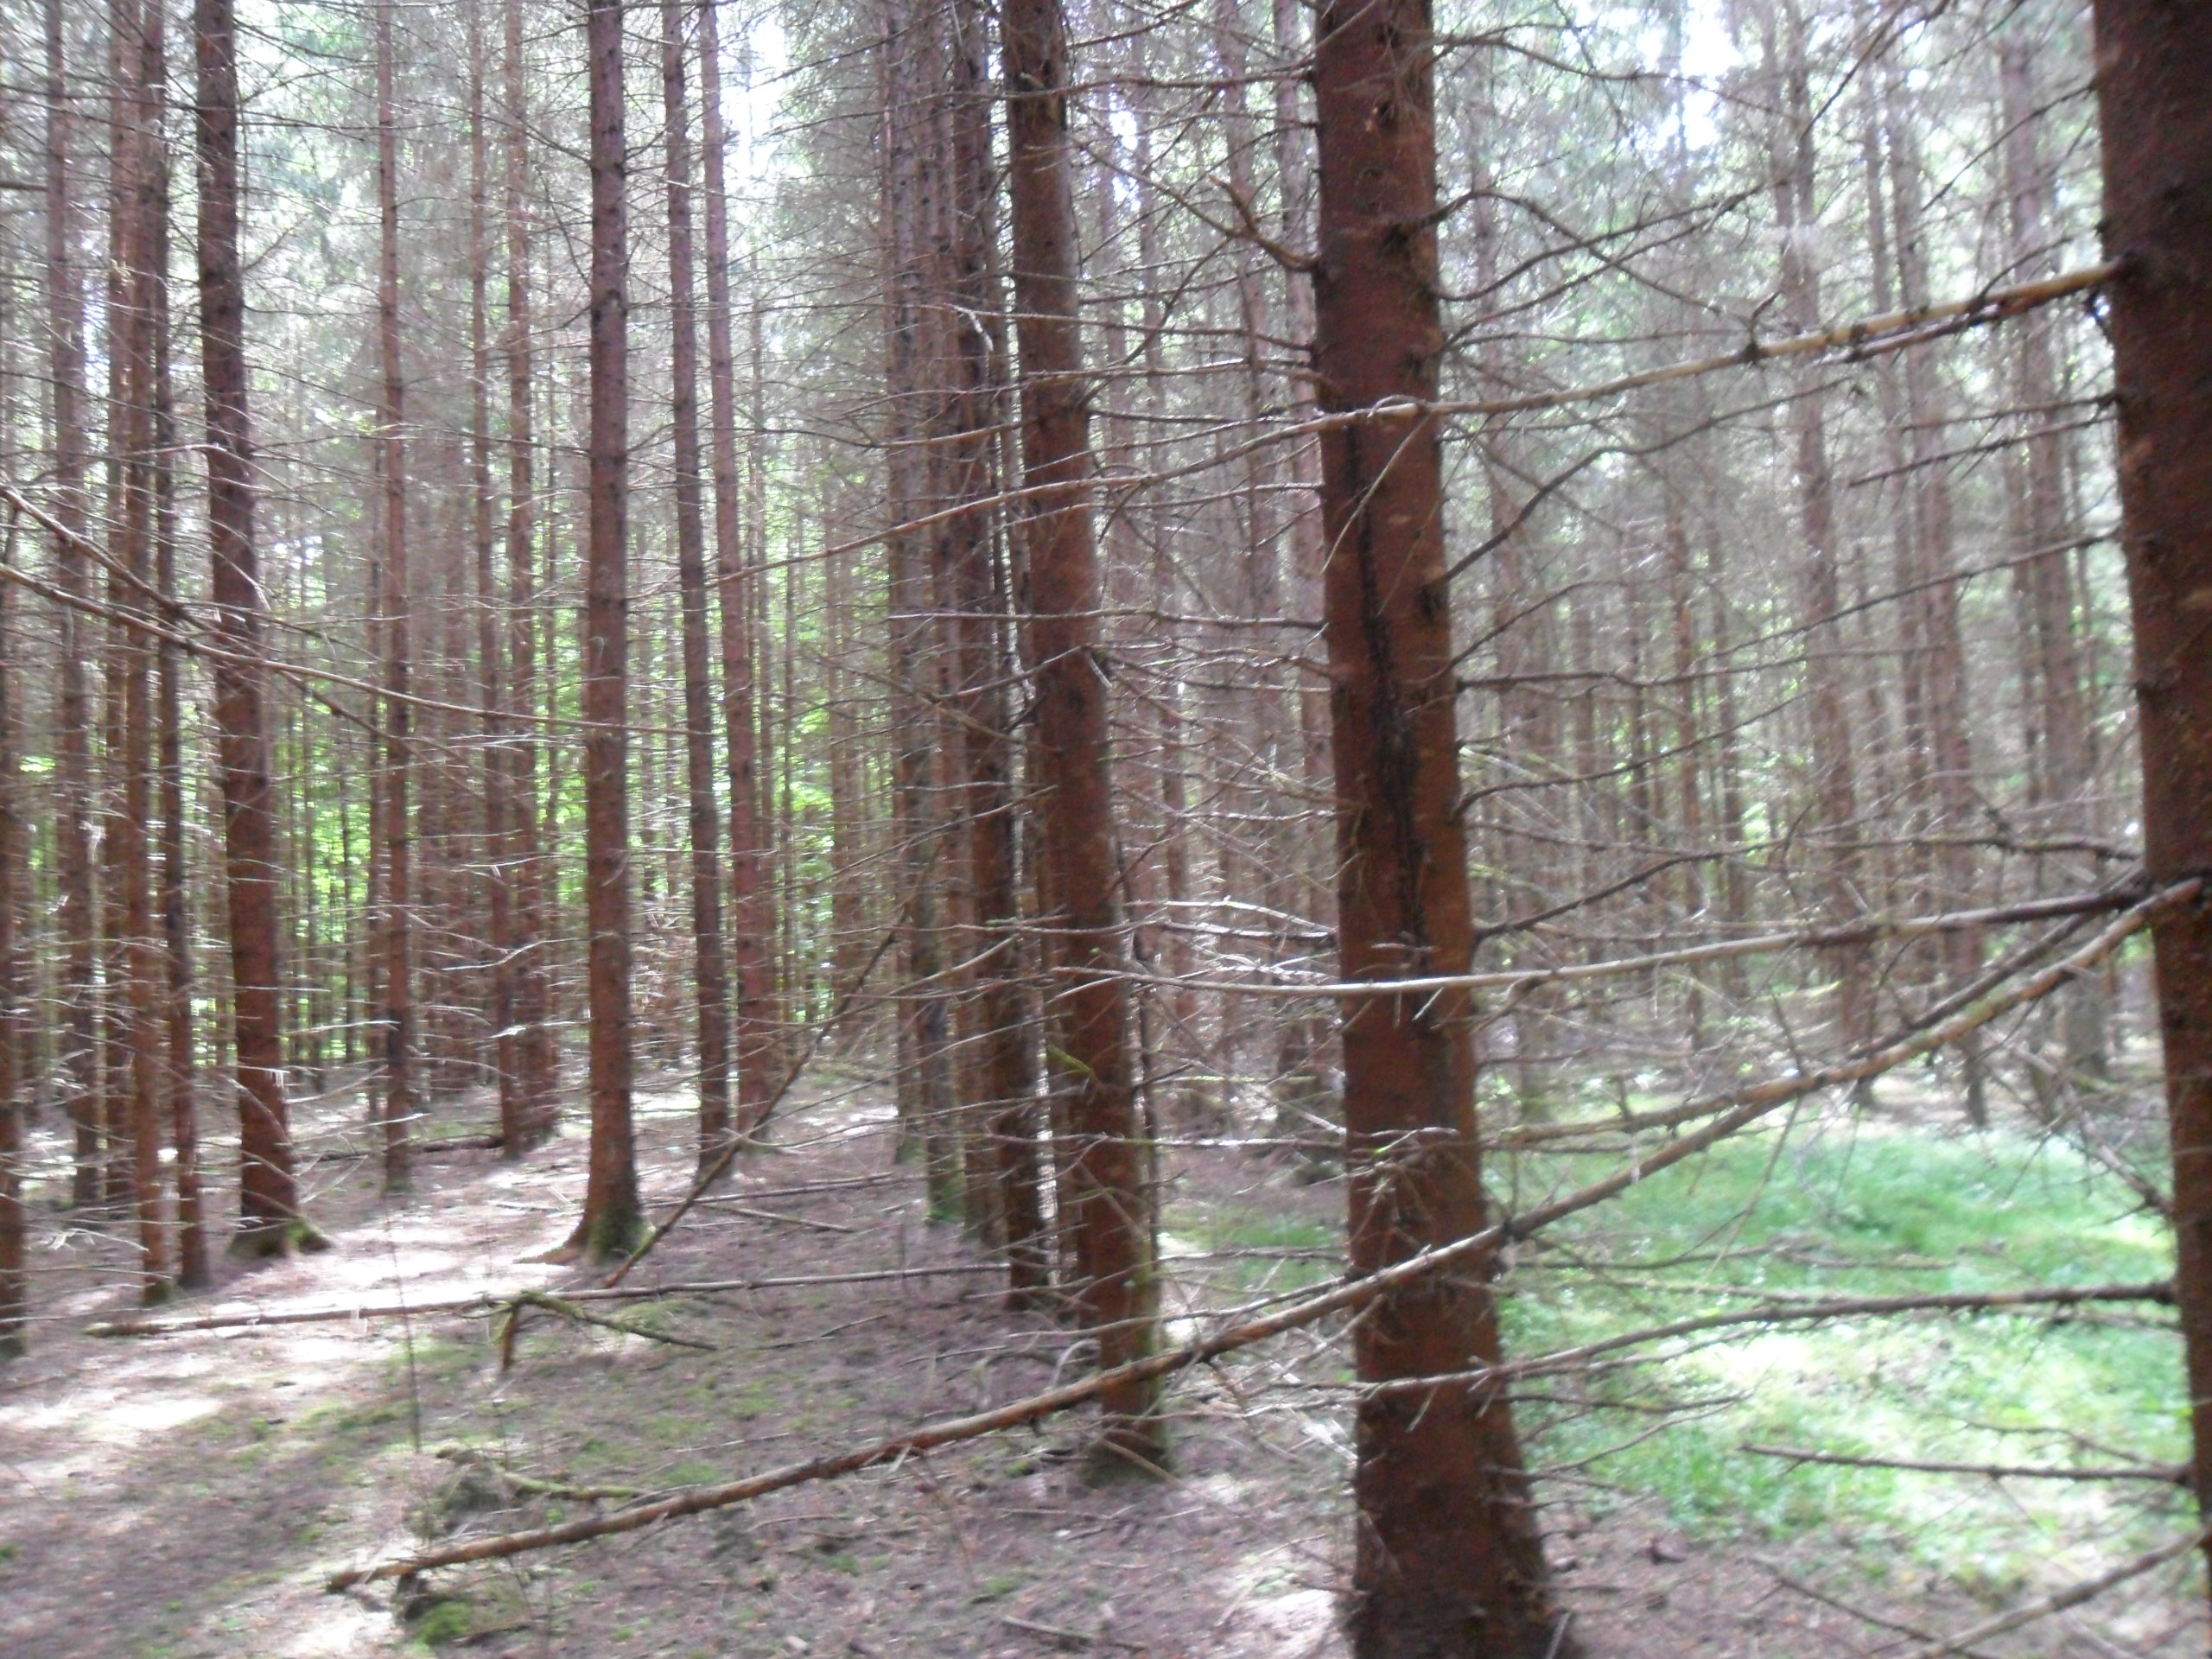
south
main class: Woodland
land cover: Spruce dominated coniferous woodland
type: hemiboreal forest and nemoral coniferous forest and mixed broadleaved-coniferous forest
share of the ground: > 75 %
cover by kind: coniferous forest trees 100 %
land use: Forestry
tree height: > 5 m
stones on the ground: < 10 %
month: June
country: LV
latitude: 57.4391
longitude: 22.4299
